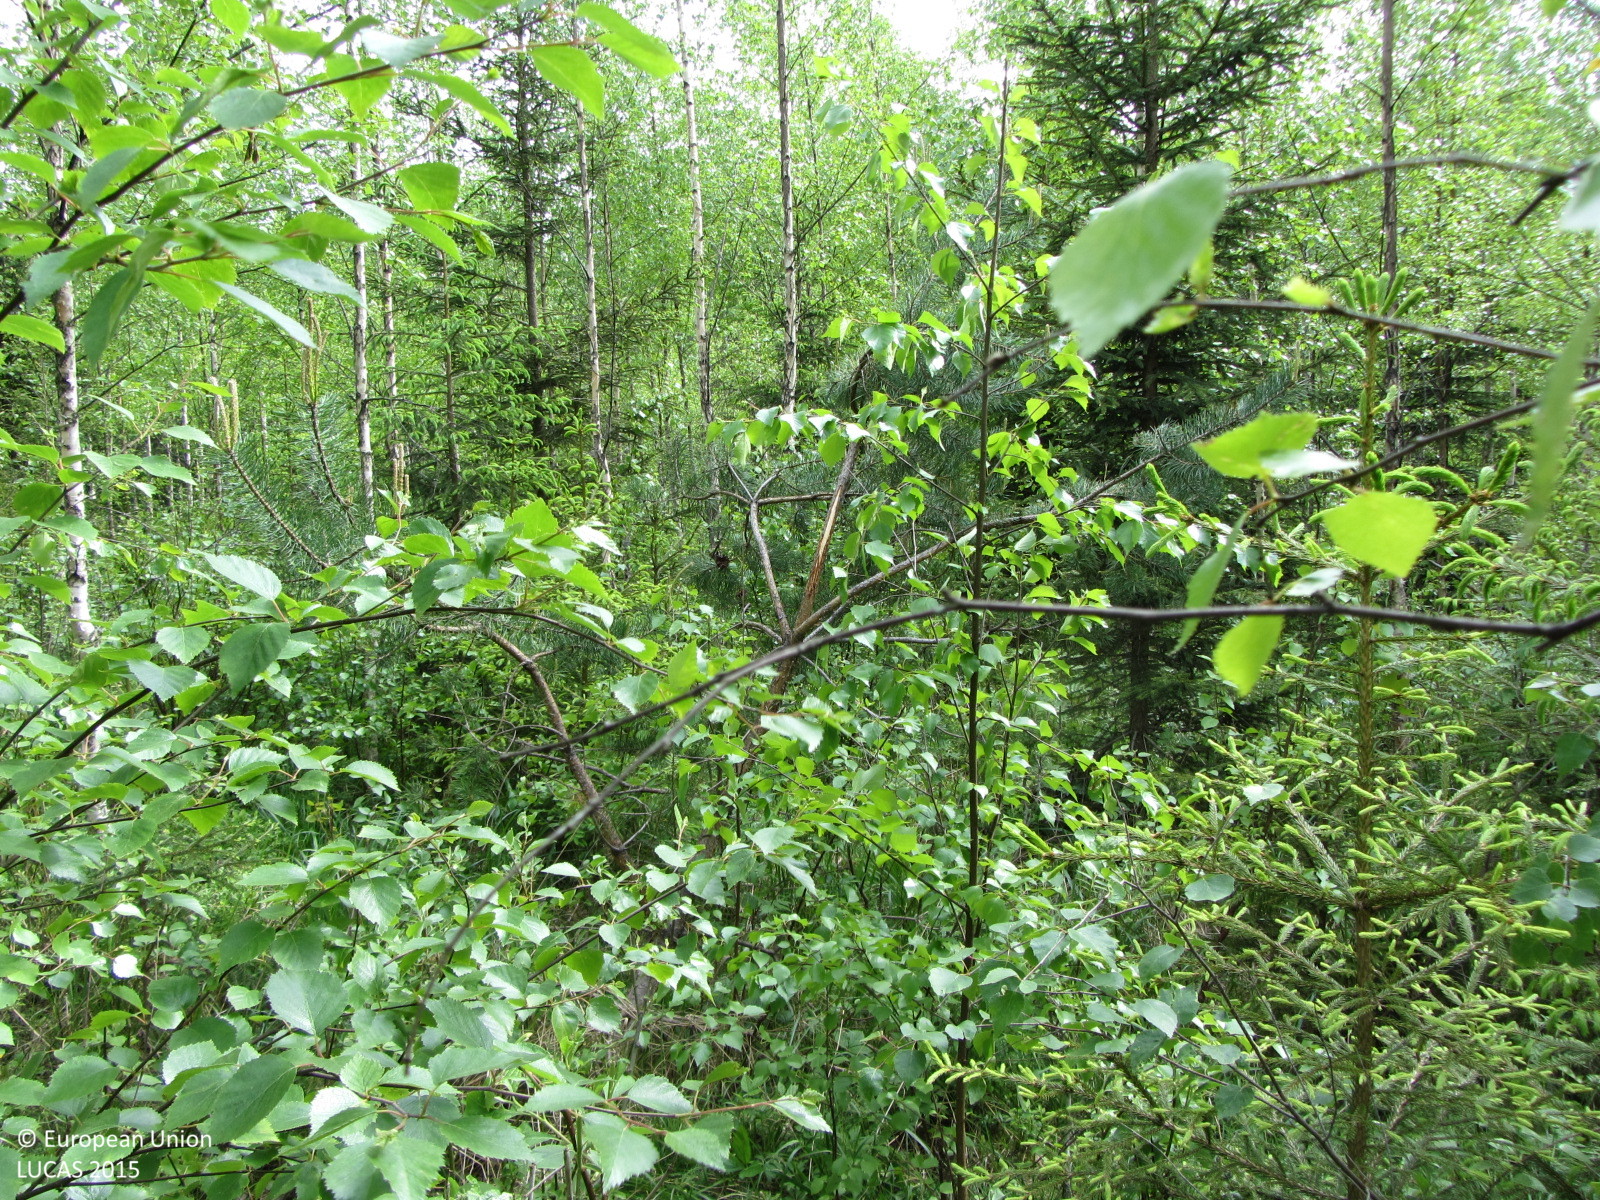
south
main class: Woodland
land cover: Broadleaved woodland
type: boreal forest
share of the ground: > 75 %
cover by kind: broadleaved forest trees 80 %, herbaceous plants 15 %, coniferous forest trees 5 %
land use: Forestry
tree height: > 5 m
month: June
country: FI
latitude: 60.2821
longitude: 24.5585
